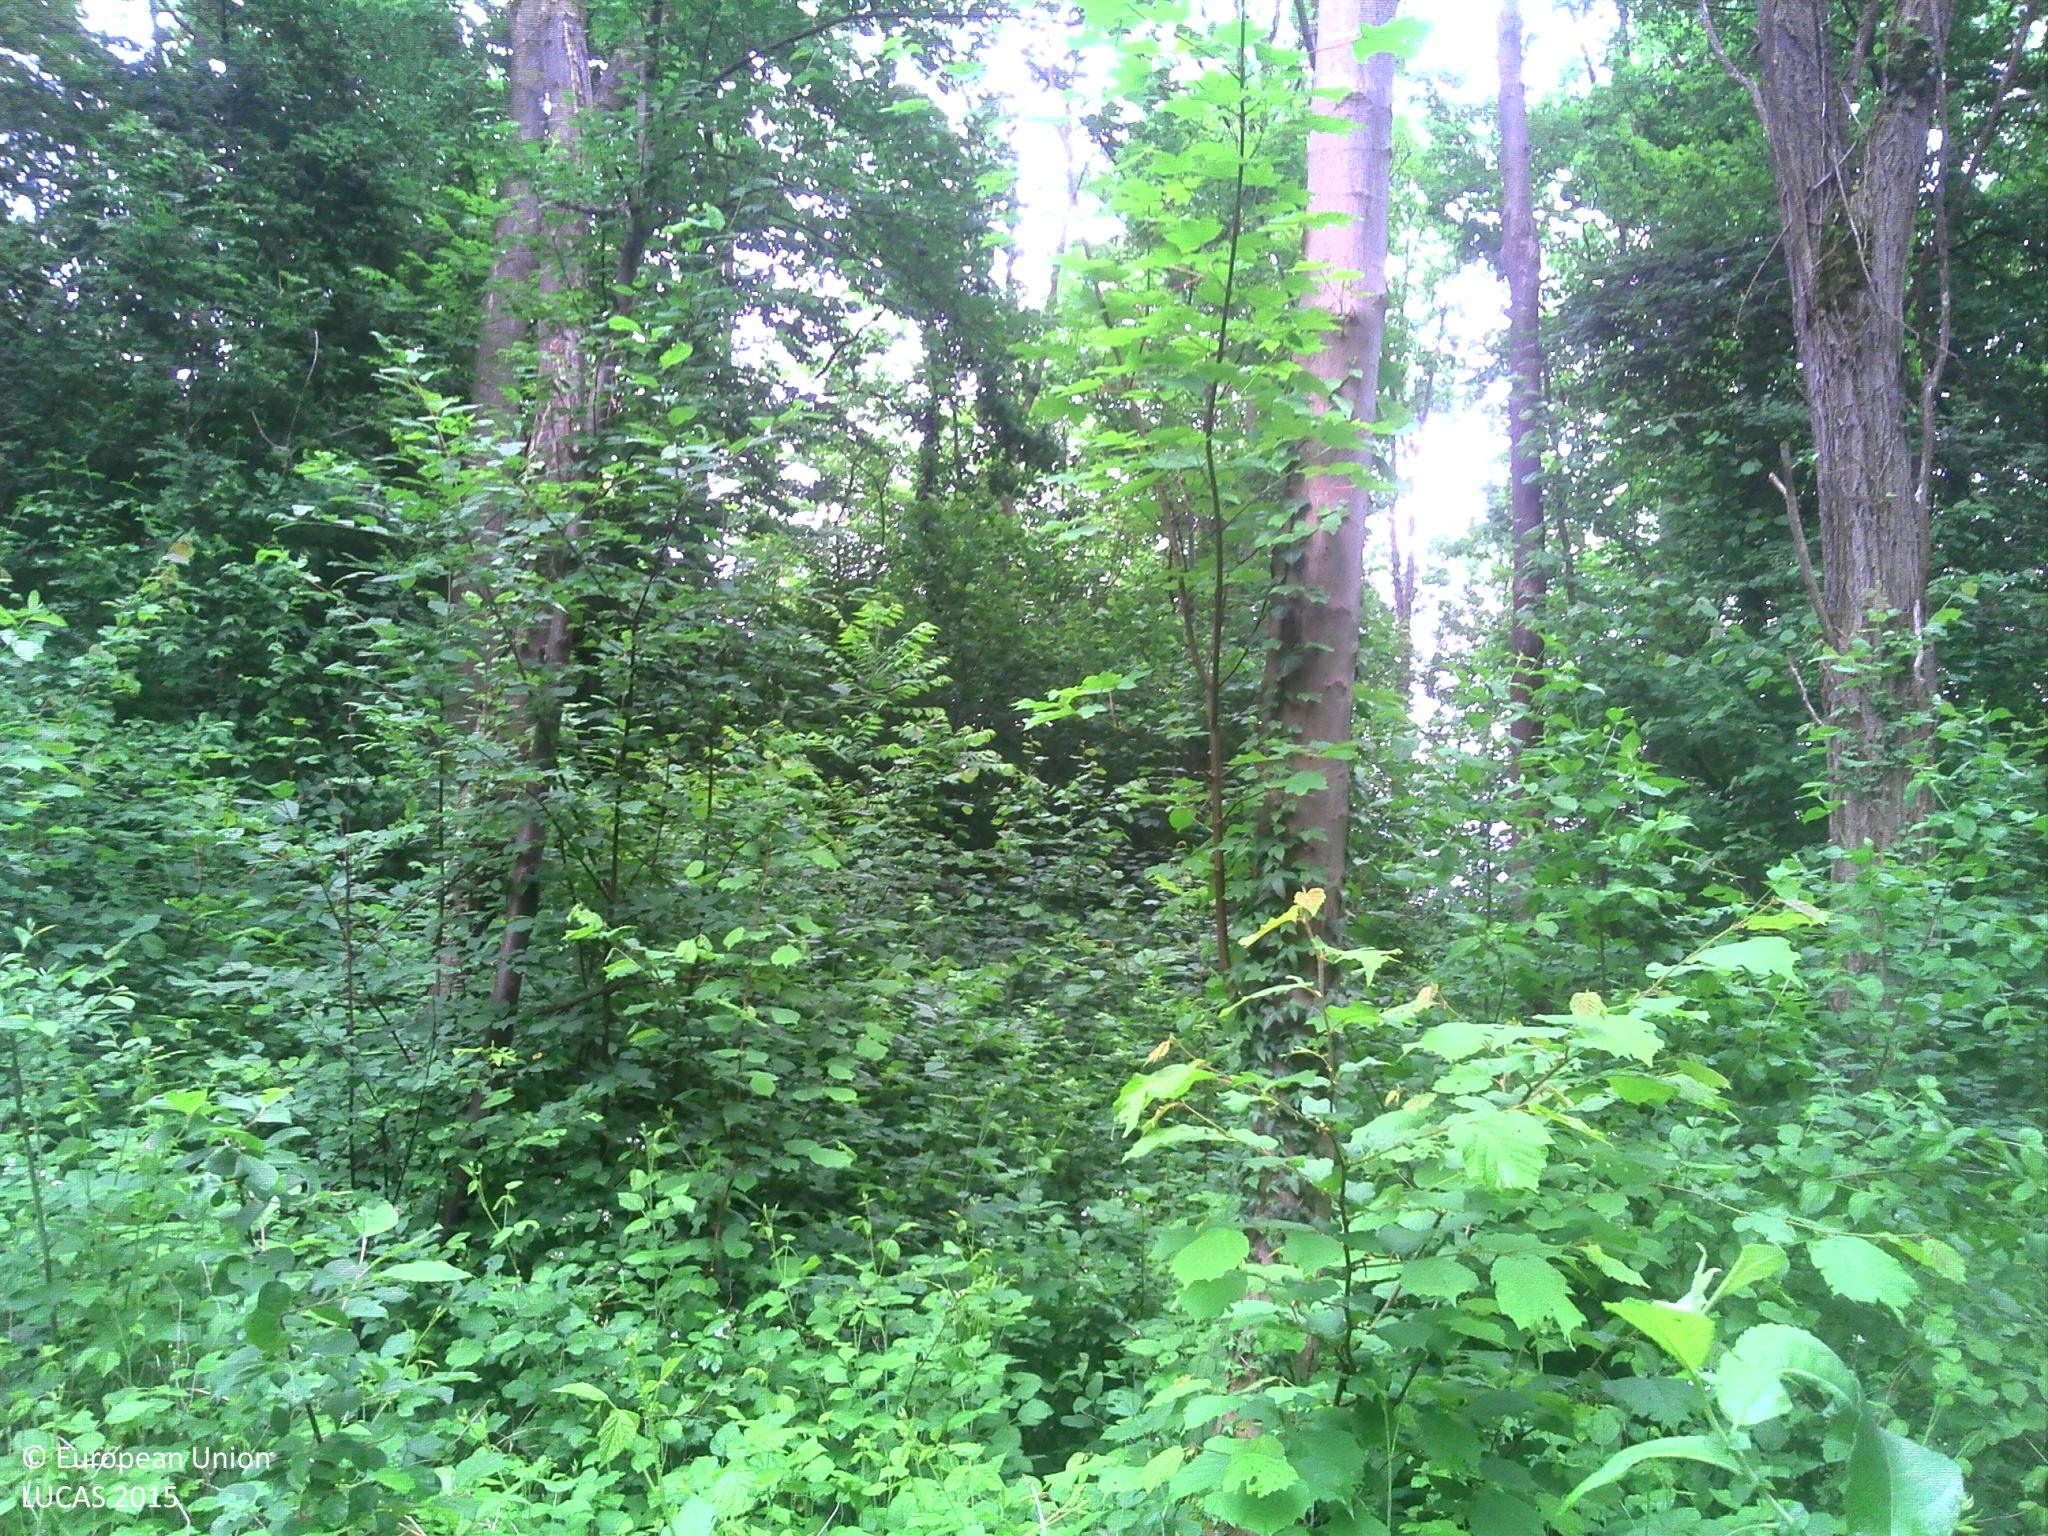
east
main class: Woodland
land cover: Broadleaved woodland
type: mesophytic deciduous forest
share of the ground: > 75 %
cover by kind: broadleaved forest trees 90 %, herbaceous plants 10 %
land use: Forestry
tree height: > 5 m
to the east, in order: Broadleaved woodland; Grassland without tree/shrub cover; Maize
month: May
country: FR
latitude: 48.2704
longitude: 7.6432
